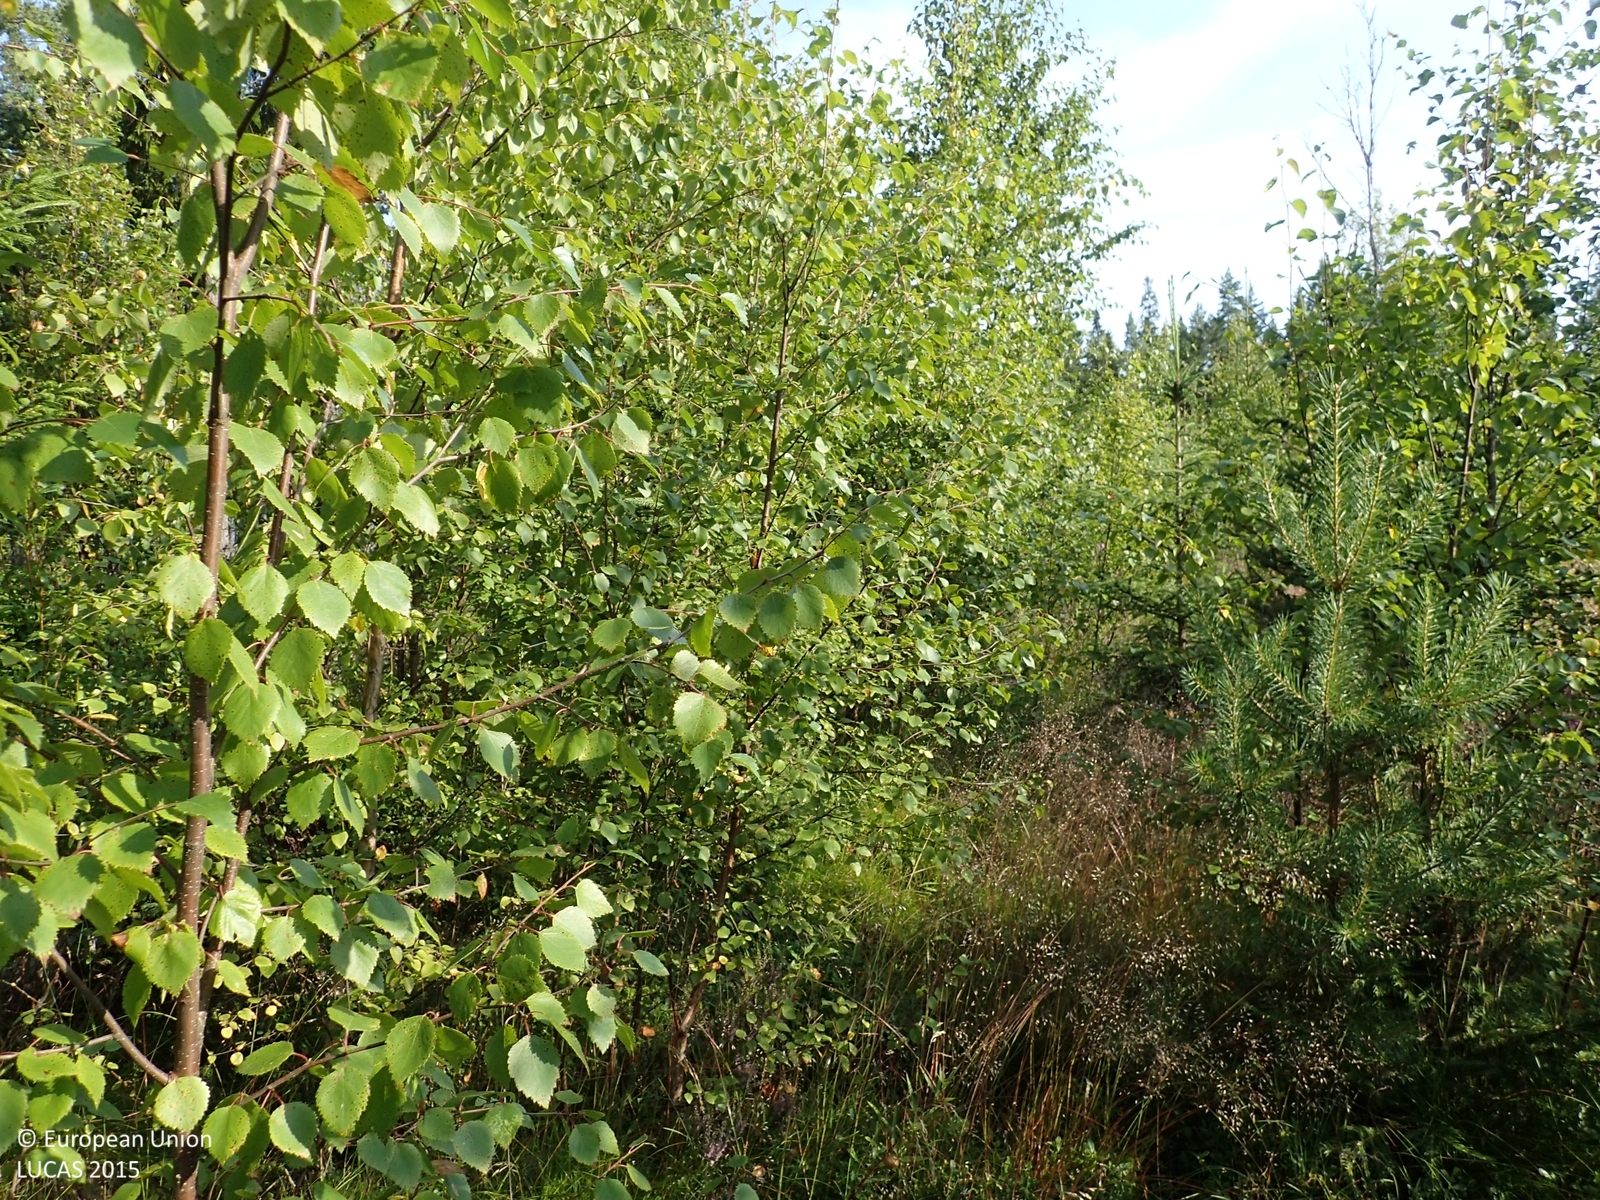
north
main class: Woodland
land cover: Other mixed woodland
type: boreal forest
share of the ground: > 75 %
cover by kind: broadleaved forest trees 55 %, coniferous forest trees 20 %, herbaceous plants 15 %, shrubs 10 %
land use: Forestry
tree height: < 5 m
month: August
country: FI
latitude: 62.6212
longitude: 22.0360
